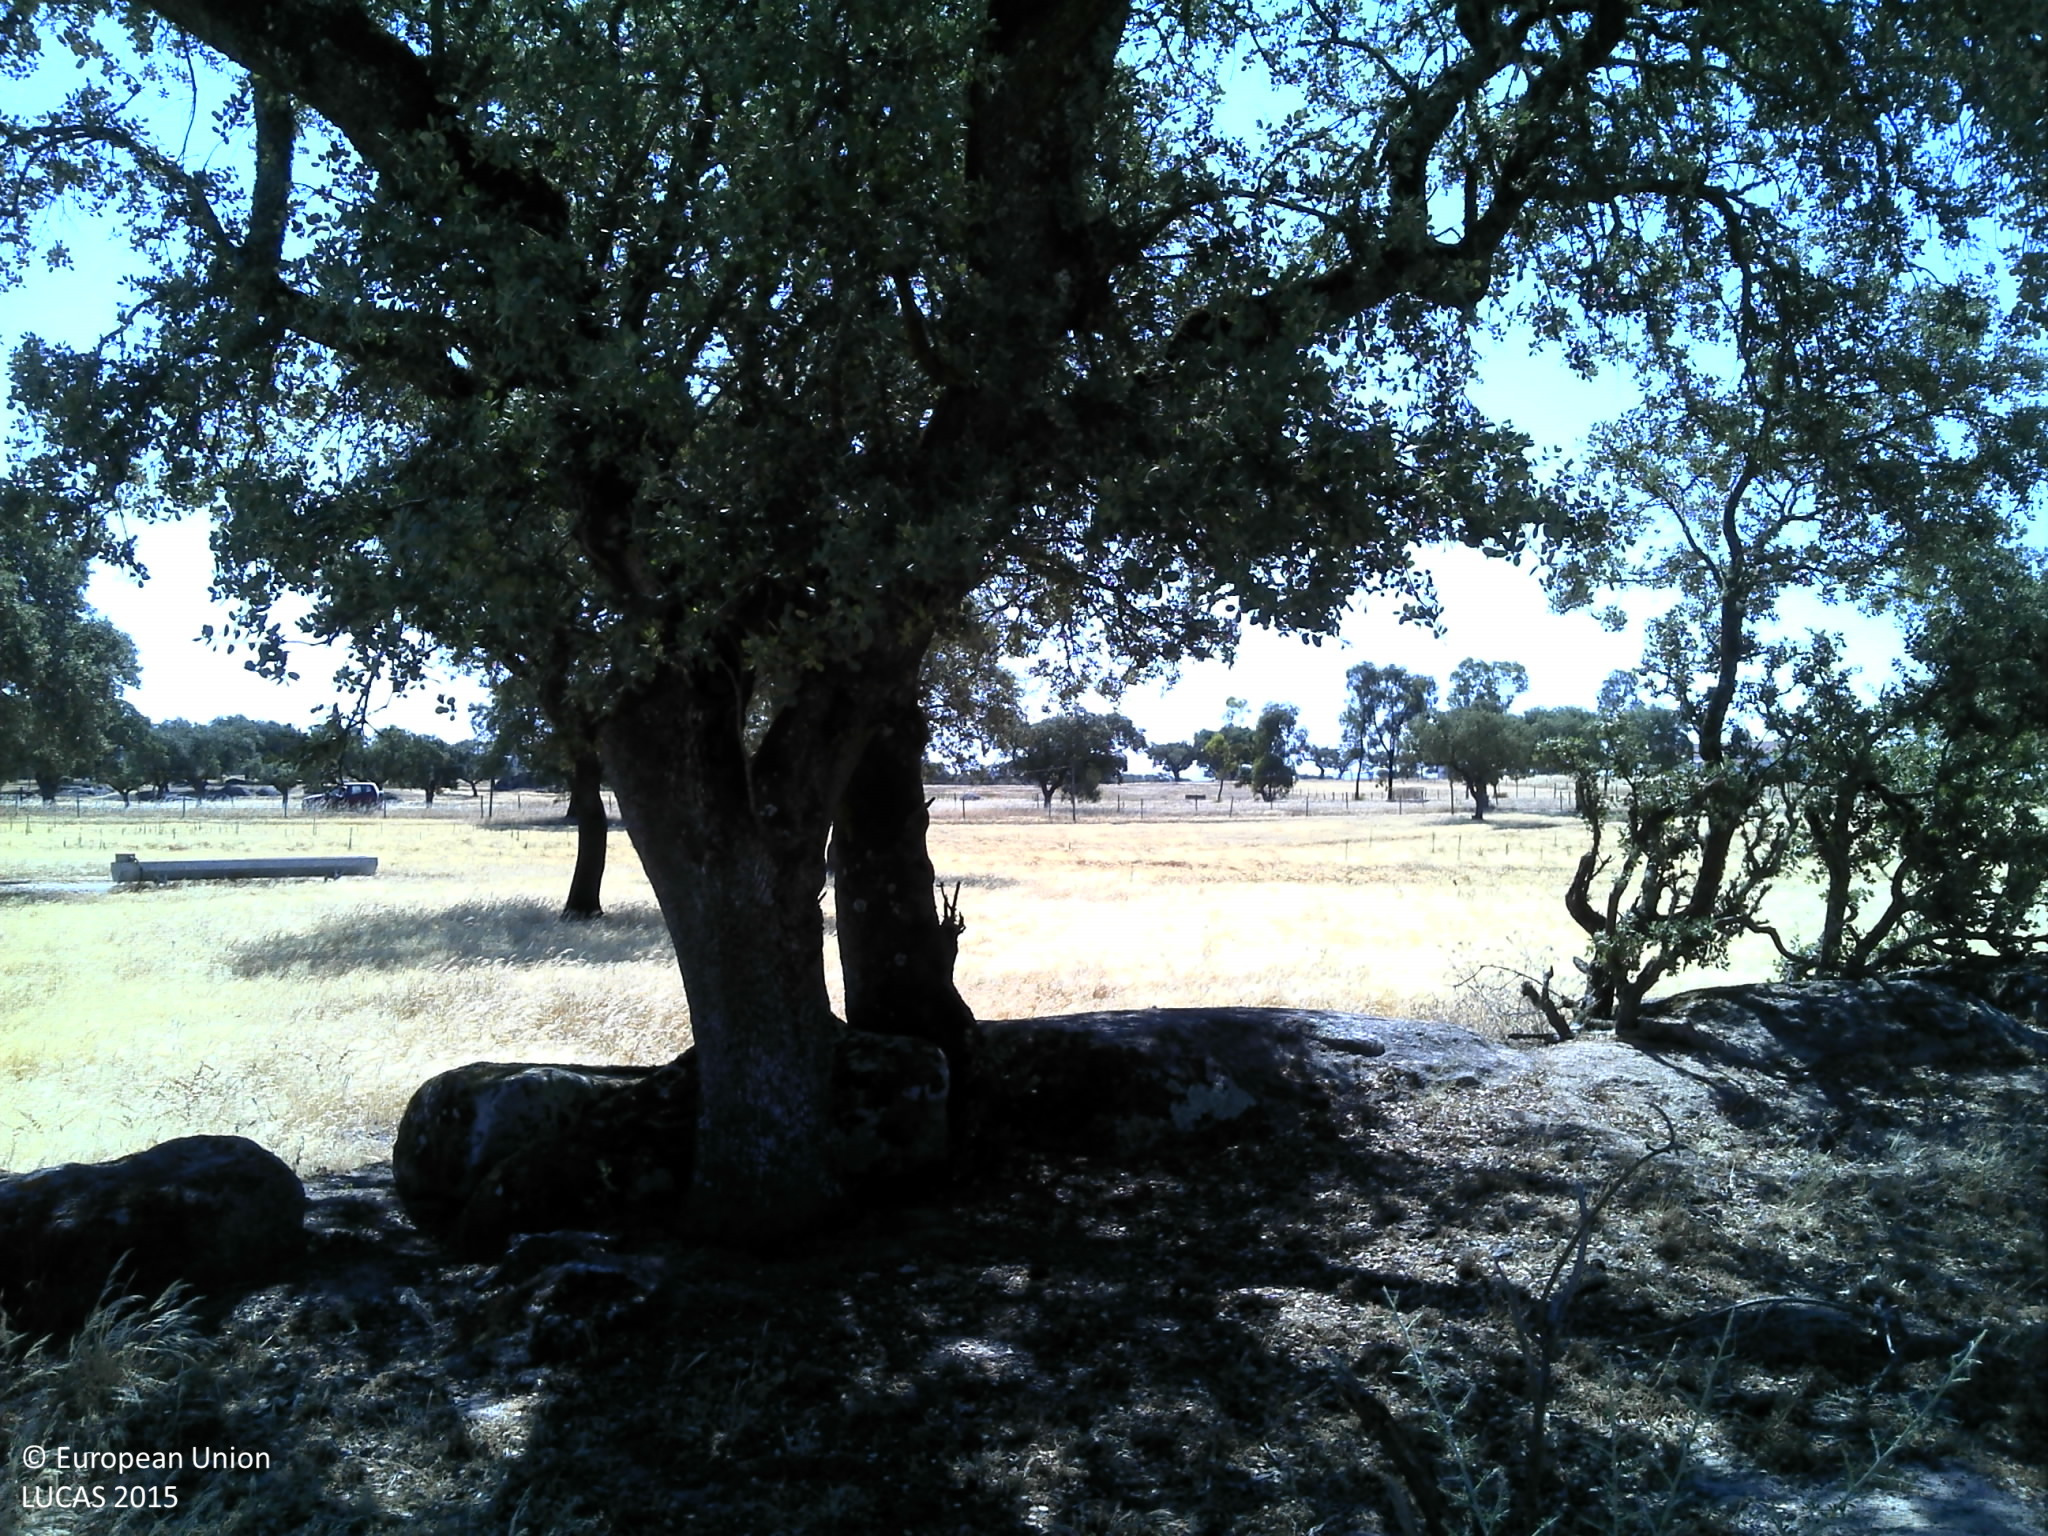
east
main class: Woodland
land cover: Broadleaved woodland
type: broadleaved evergreen forest
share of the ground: 10 - 25 %
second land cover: Grassland without tree/shrub cover
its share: 50 - 75 %
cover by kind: herbaceous plants 60 %, broadleaved forest trees 30 %, consolidated bare surface 10 %
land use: Forestry
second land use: Agriculture (excluding fallow land and kitchen gardens)
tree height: > 5 m
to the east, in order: Broadleaved woodland; Grassland without tree/shrub cover; Broadleaved woodland; Grassland without tree/shrub cover; Fences; Grass margins; Tracks; Grass margins; Fences; Broadleaved woodland; Grassland without tree/shrub cover; Rock outcrops; Broadleaved woodland
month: June
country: PT
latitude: 38.8610
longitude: -7.9193
